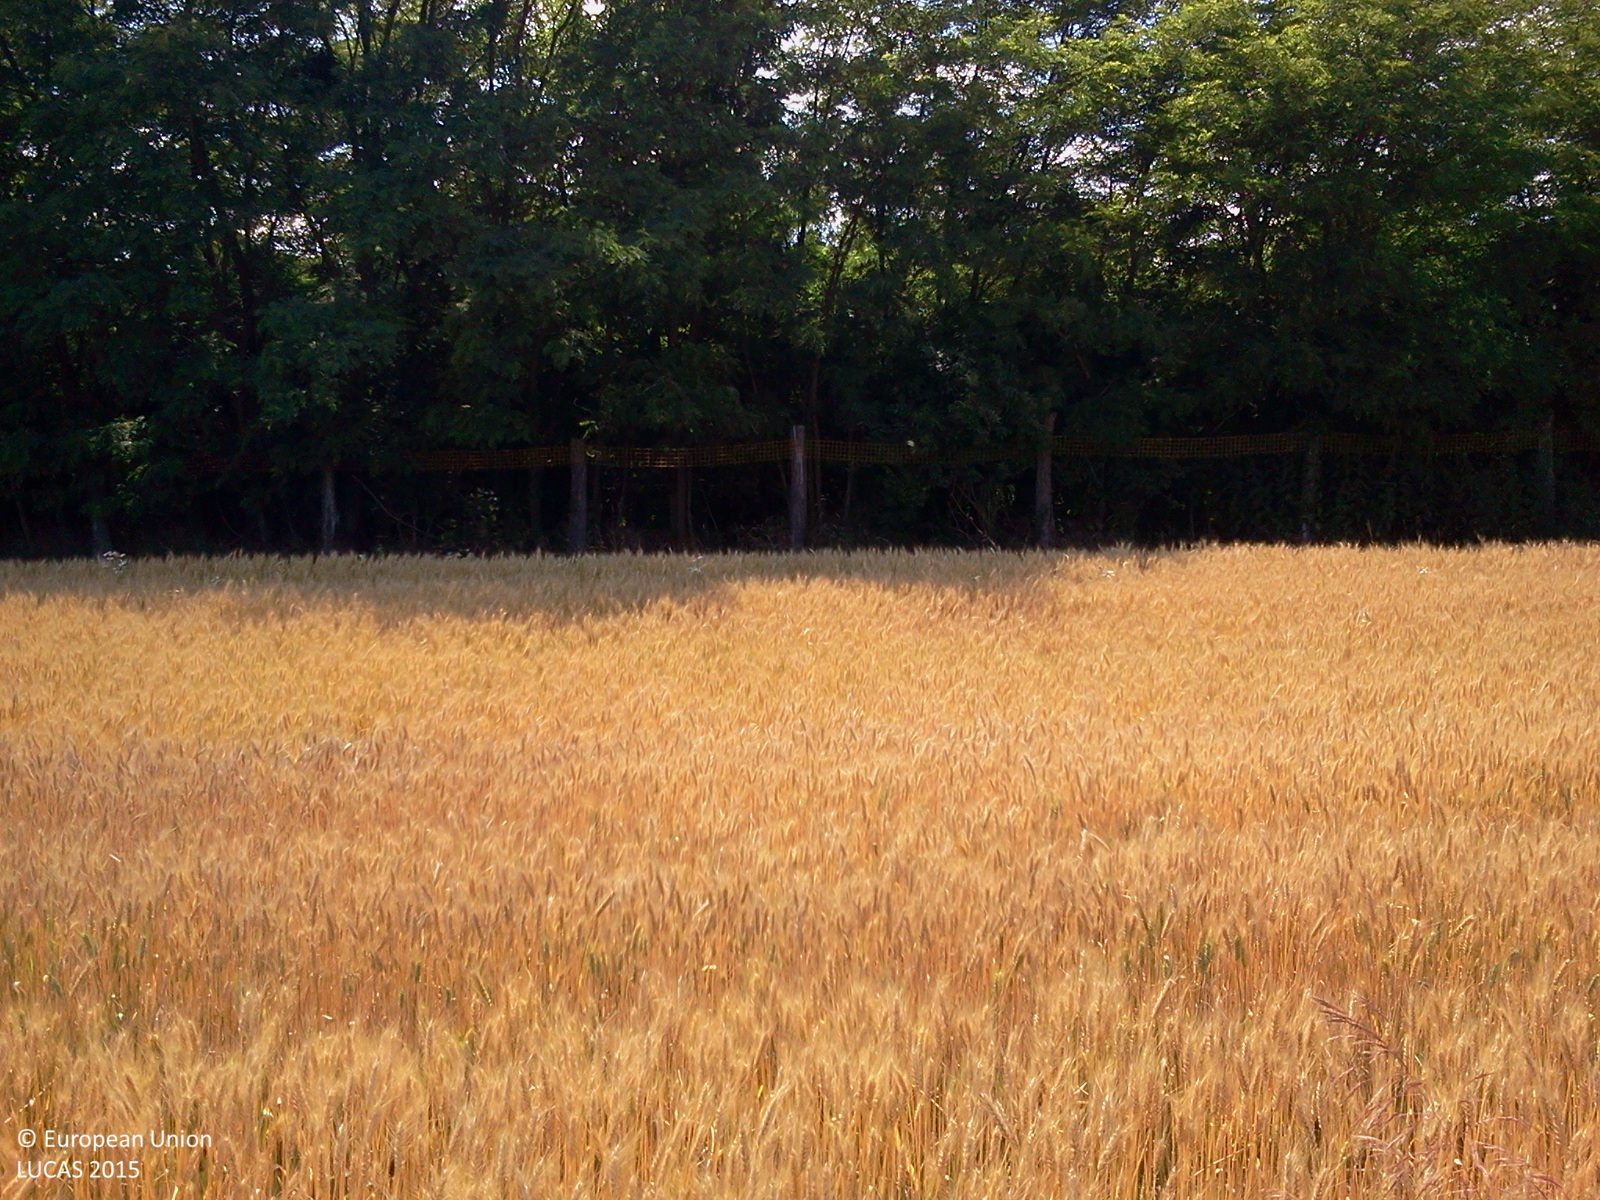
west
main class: Cropland
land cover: Durum wheat
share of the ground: > 75 %
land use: Agriculture (excluding fallow land and kitchen gardens)
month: June
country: HU
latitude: 46.9244
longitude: 17.1621
